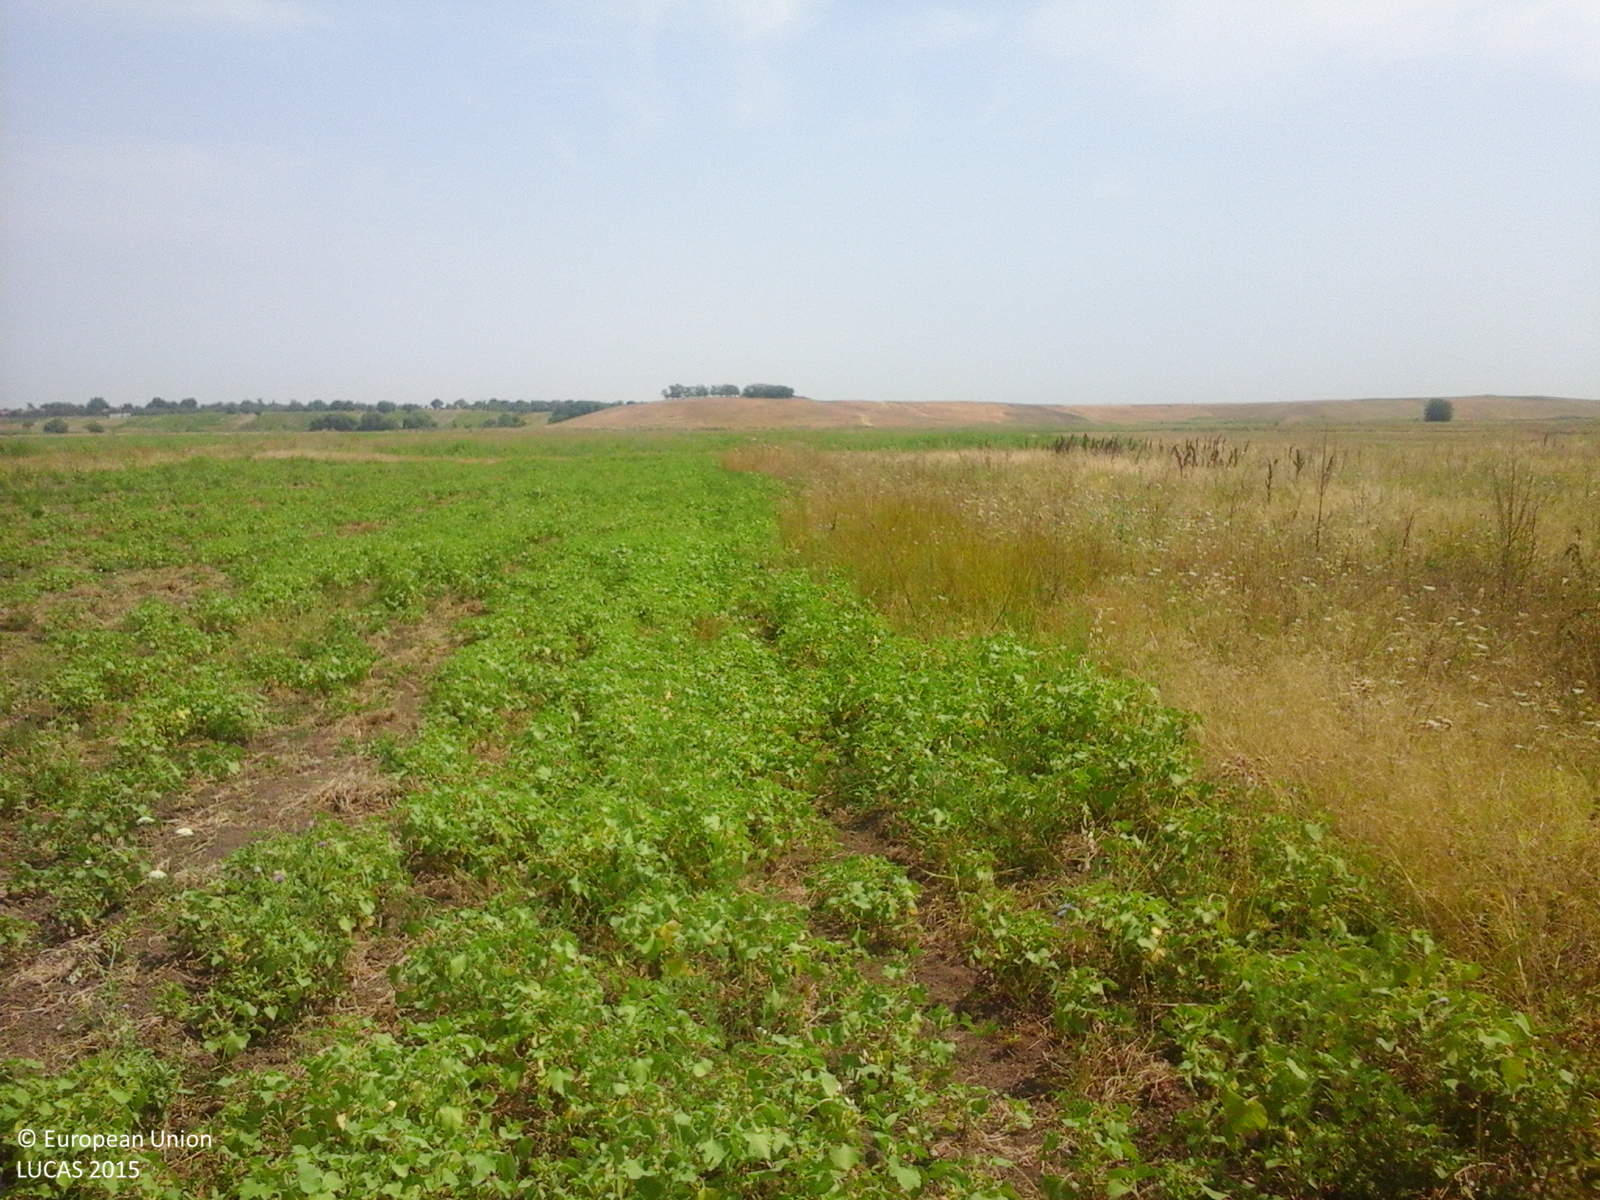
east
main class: Grassland
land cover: Spontaneously vegetated surfaces
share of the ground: > 75 %
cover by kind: herbaceous plants 100 %
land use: Fallow land
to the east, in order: Spontaneously vegetated surfaces; Grass margins; Tracks; Grass margins; Spontaneously vegetated surfaces; Common wheat
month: August
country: RO
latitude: 44.2672
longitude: 22.9332
